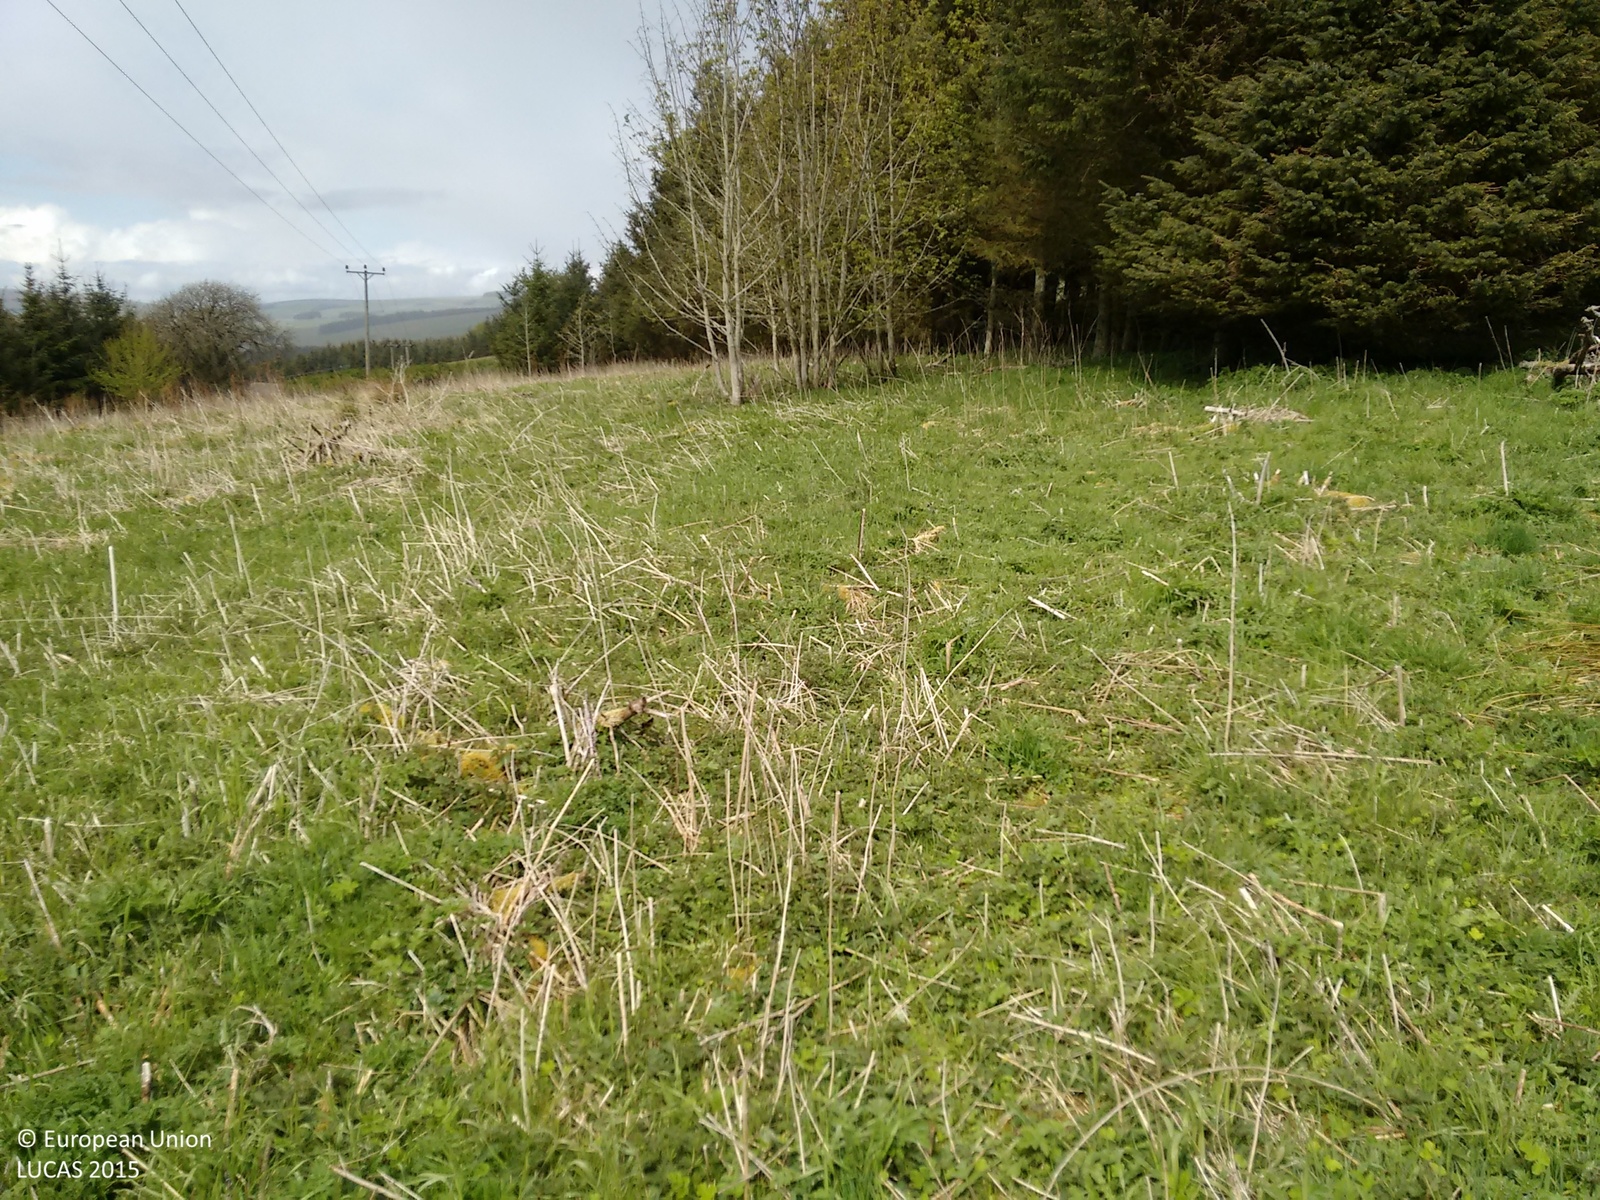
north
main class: Grassland
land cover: Spontaneously vegetated surfaces
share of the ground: > 75 %
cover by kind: herbaceous plants 95 %, shrubs 5 %
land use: Fallow land
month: May
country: GB
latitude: 55.8144
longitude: -2.4588
